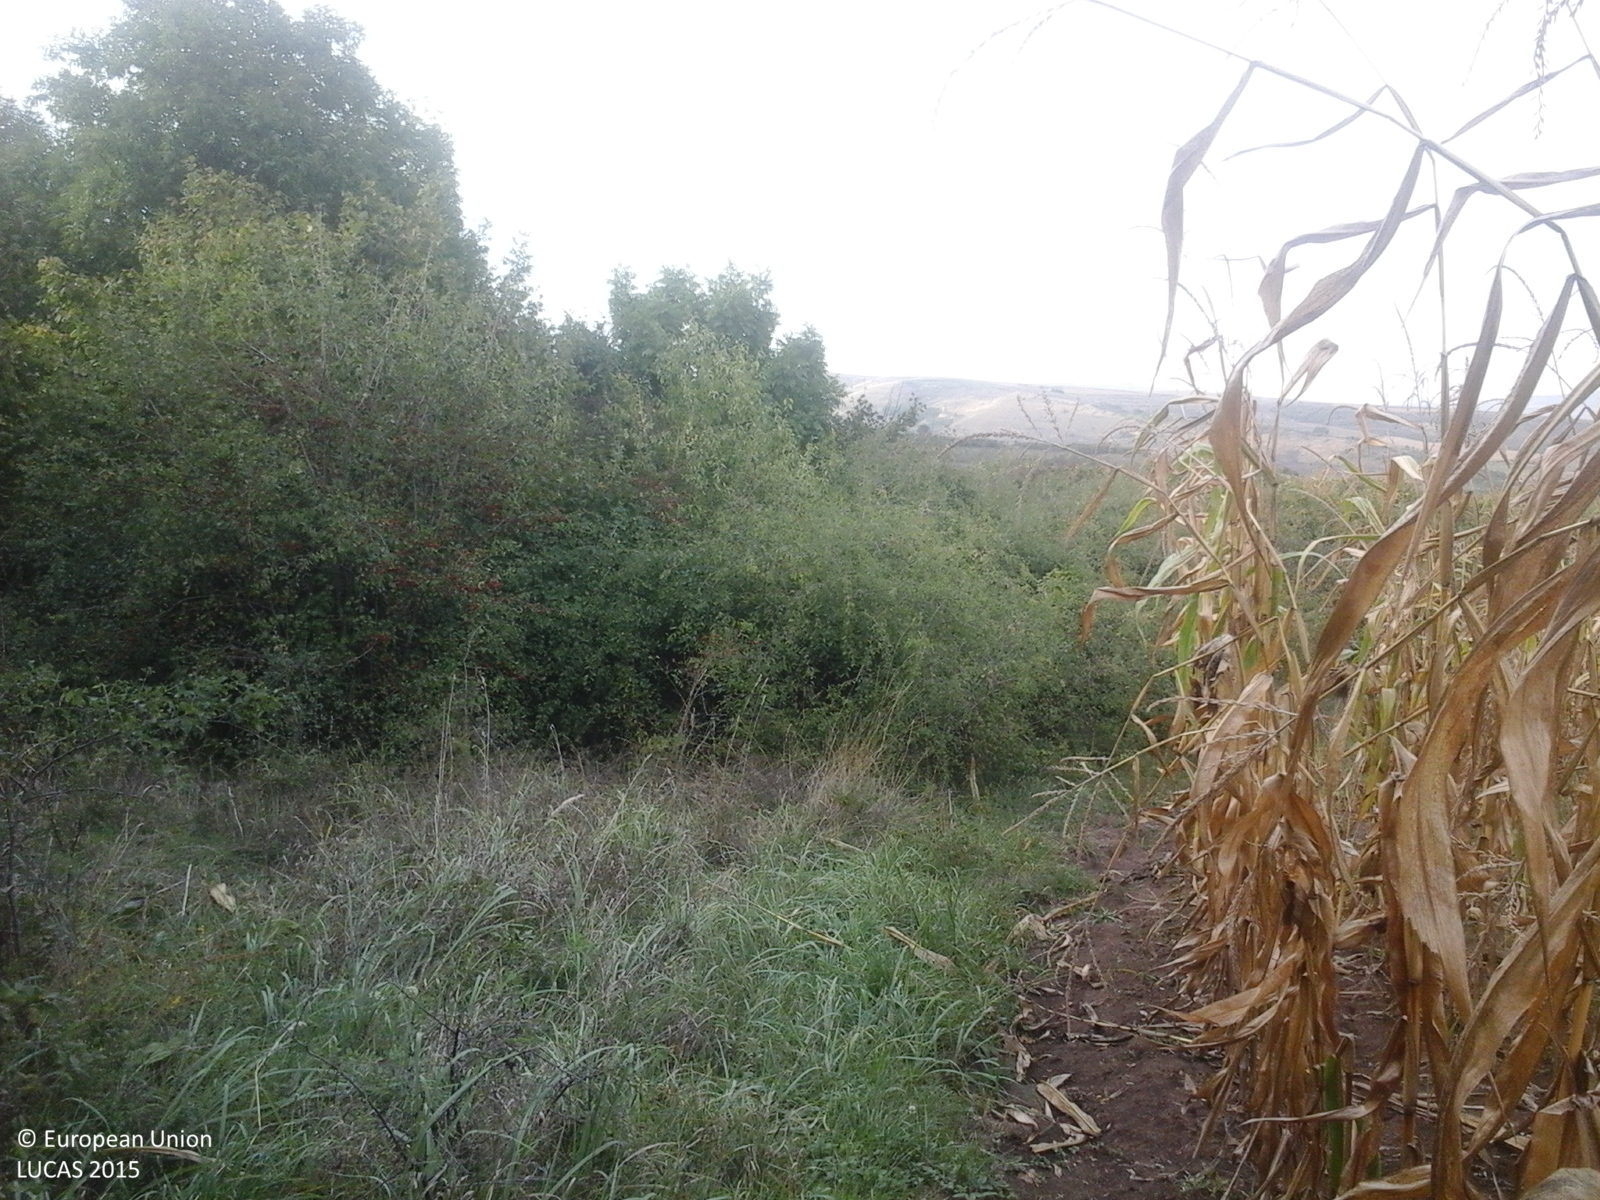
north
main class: Woodland
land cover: Broadleaved woodland
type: acidophilous oak and oak-birch forest
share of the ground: > 75 %
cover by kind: broadleaved forest trees 100 %
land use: Forestry
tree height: > 5 m
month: September
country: RO
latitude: 46.8052
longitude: 24.0617
